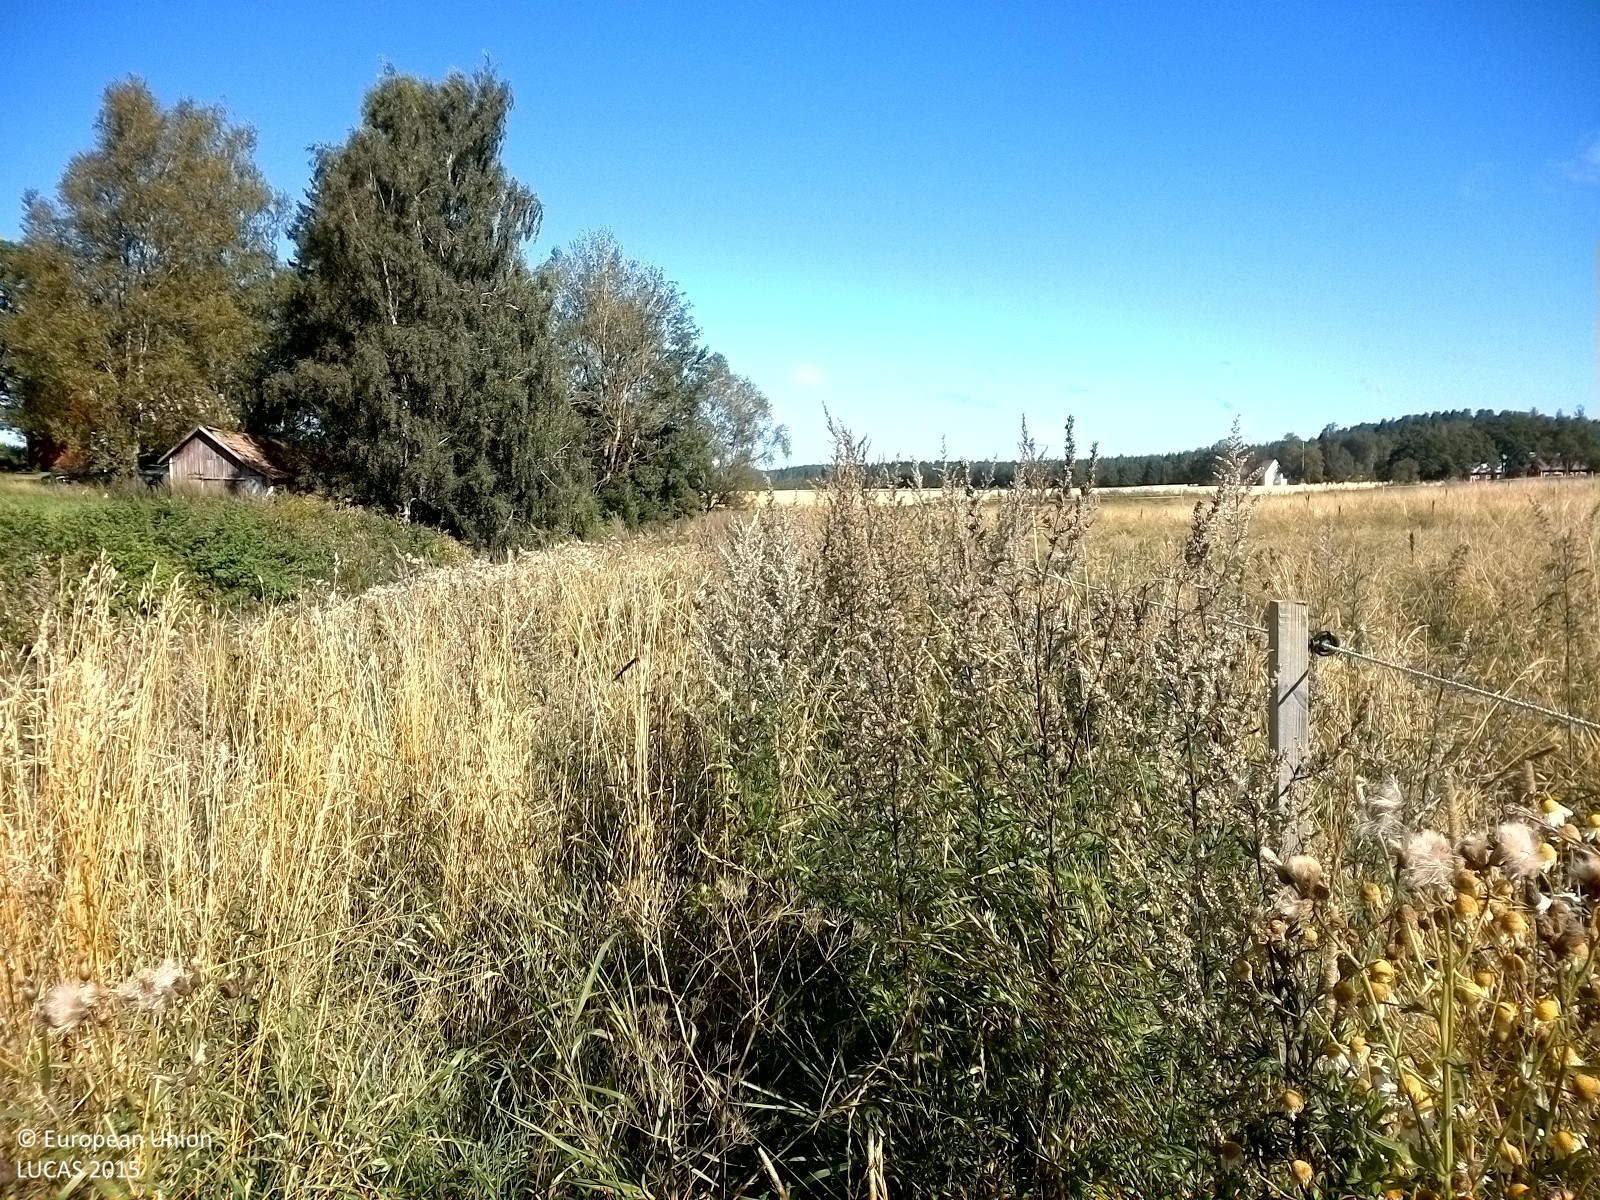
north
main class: Grassland
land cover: Grassland without tree/shrub cover
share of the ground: > 75 %
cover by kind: herbaceous plants 100 %
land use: Agriculture (excluding fallow land and kitchen gardens)
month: August
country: SE
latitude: 59.3678
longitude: 15.0764
